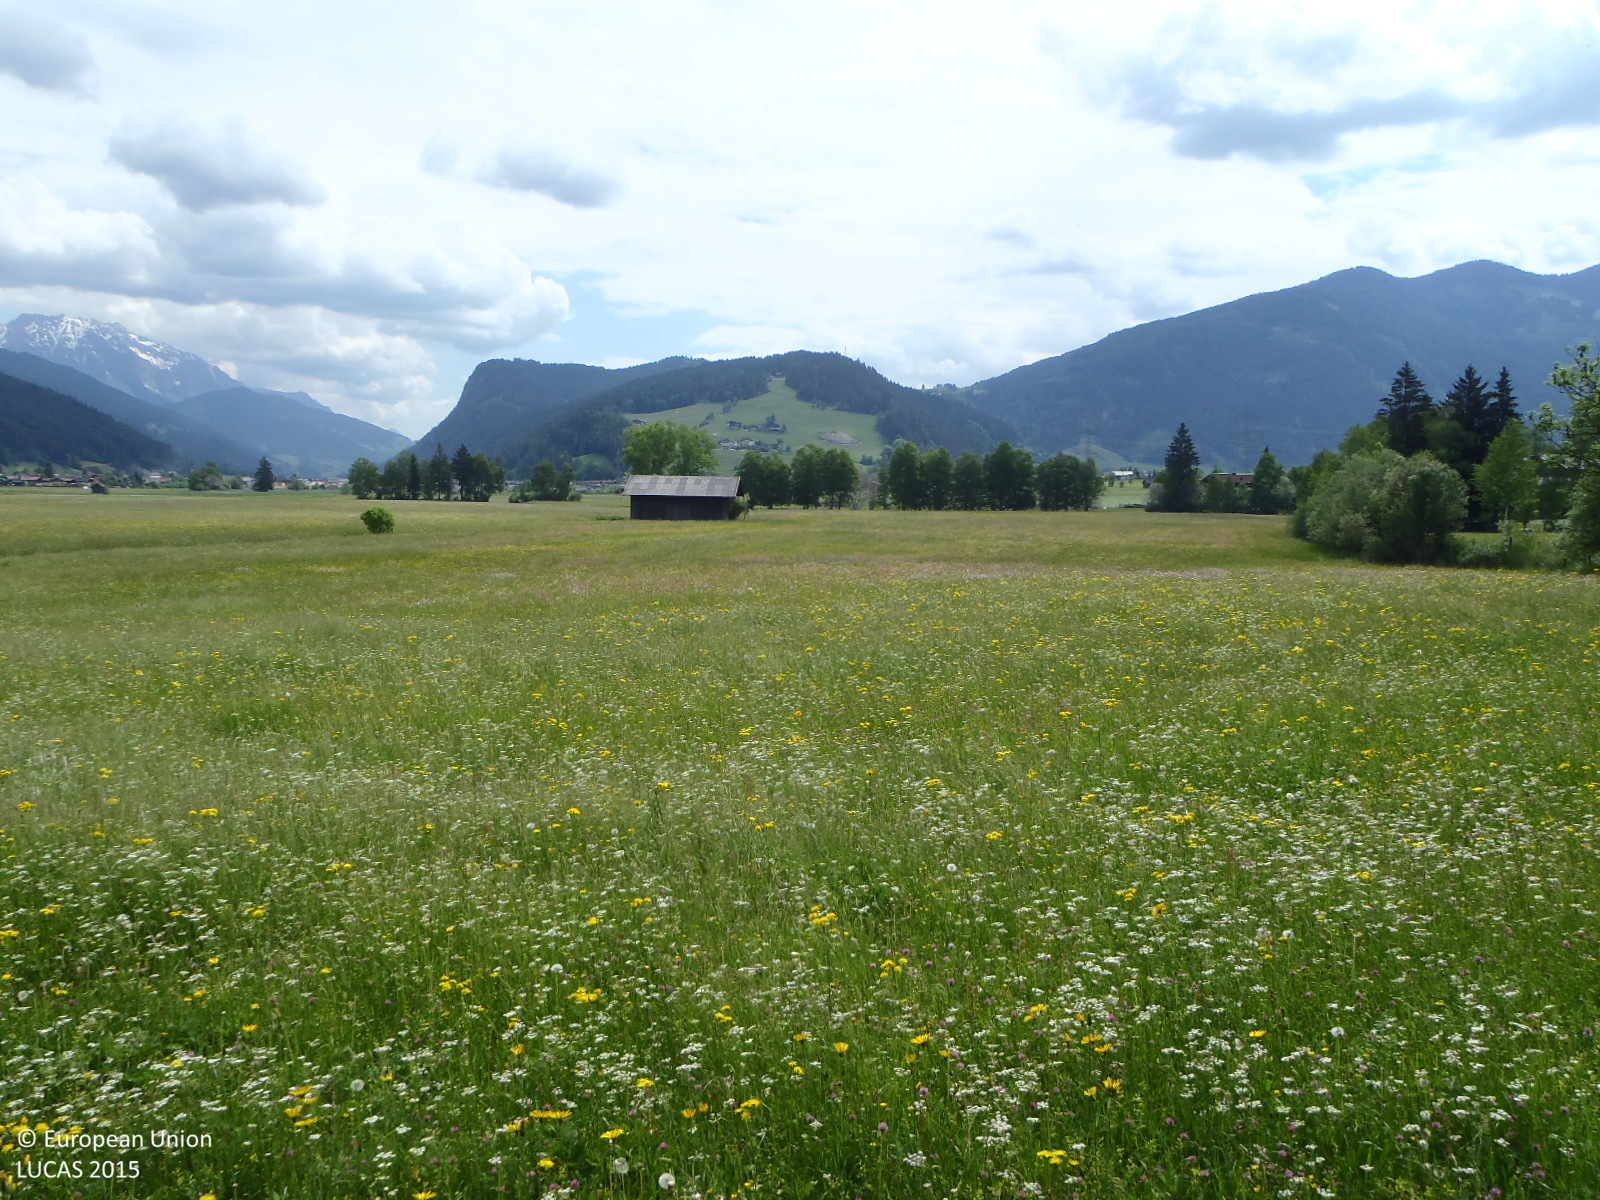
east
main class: Grassland
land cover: Grassland without tree/shrub cover
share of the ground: > 75 %
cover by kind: herbaceous plants 100 %
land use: Agriculture (excluding fallow land and kitchen gardens)
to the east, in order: Grassland without tree/shrub cover; Fences; Broadleaved woodland; Grassland without tree/shrub cover; Ditches and canals; Grassland without tree/shrub cover
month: June
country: AT
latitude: 47.3768
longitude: 13.4550
